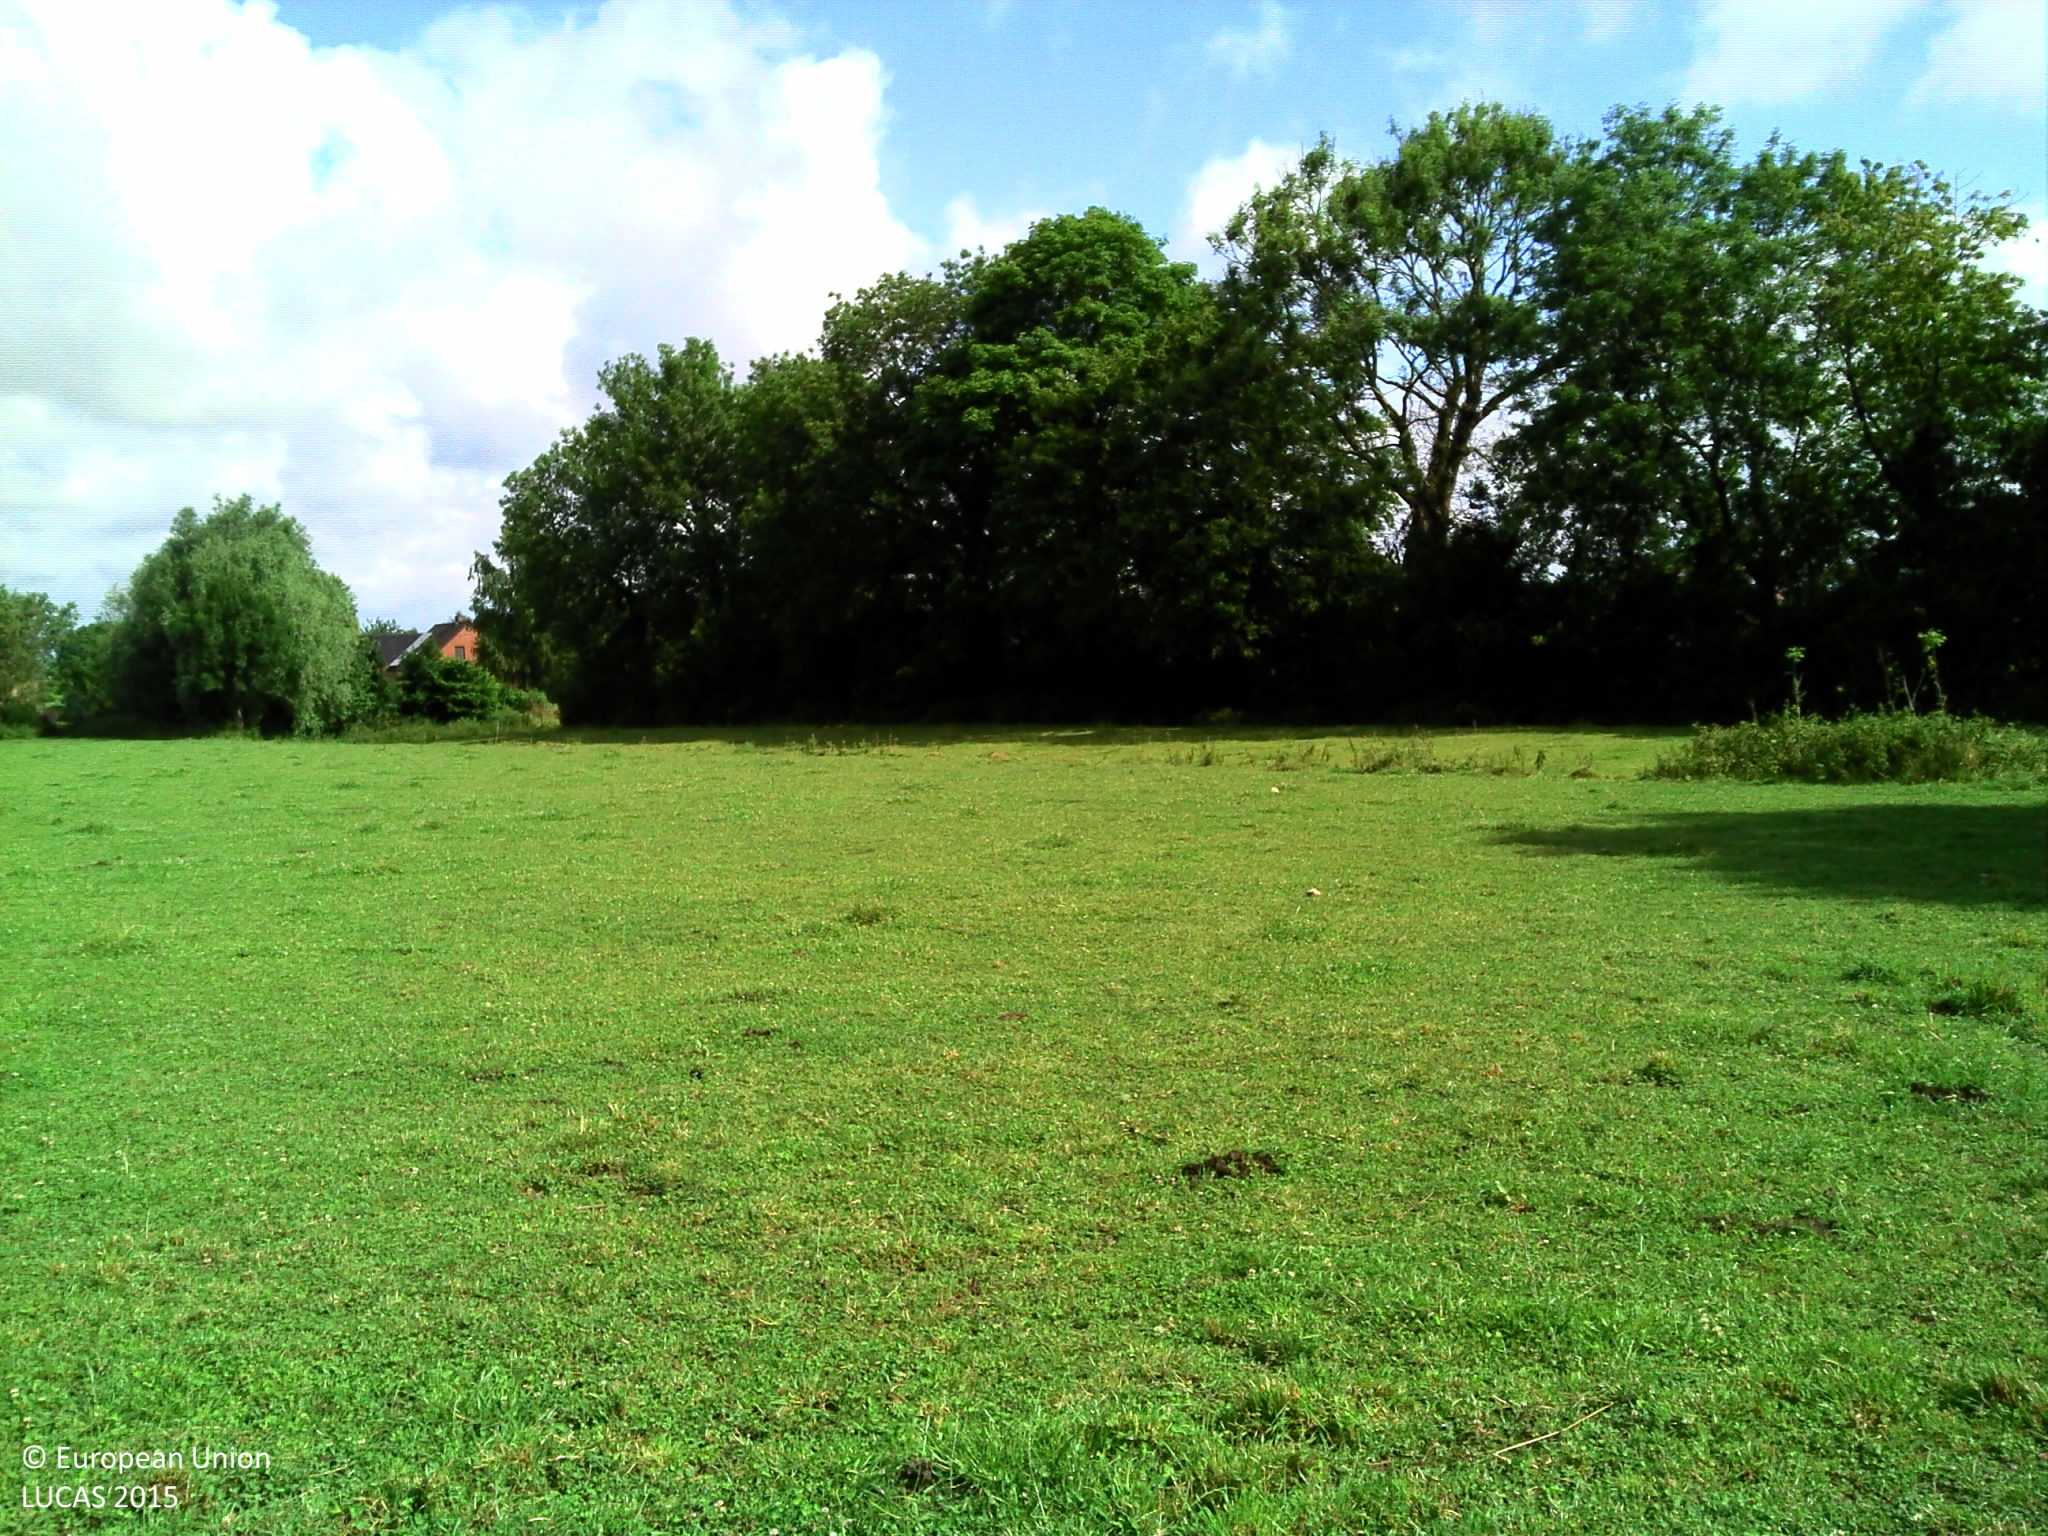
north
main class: Grassland
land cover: Grassland with sparse tree/shrub cover
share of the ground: 50 - 75 %
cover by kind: herbaceous plants 85 %, shrubs 10 %, broadleaved forest trees 5 %
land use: Agriculture (excluding fallow land and kitchen gardens)
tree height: > 5 m
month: June
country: BE
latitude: 50.5281
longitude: 3.9422
